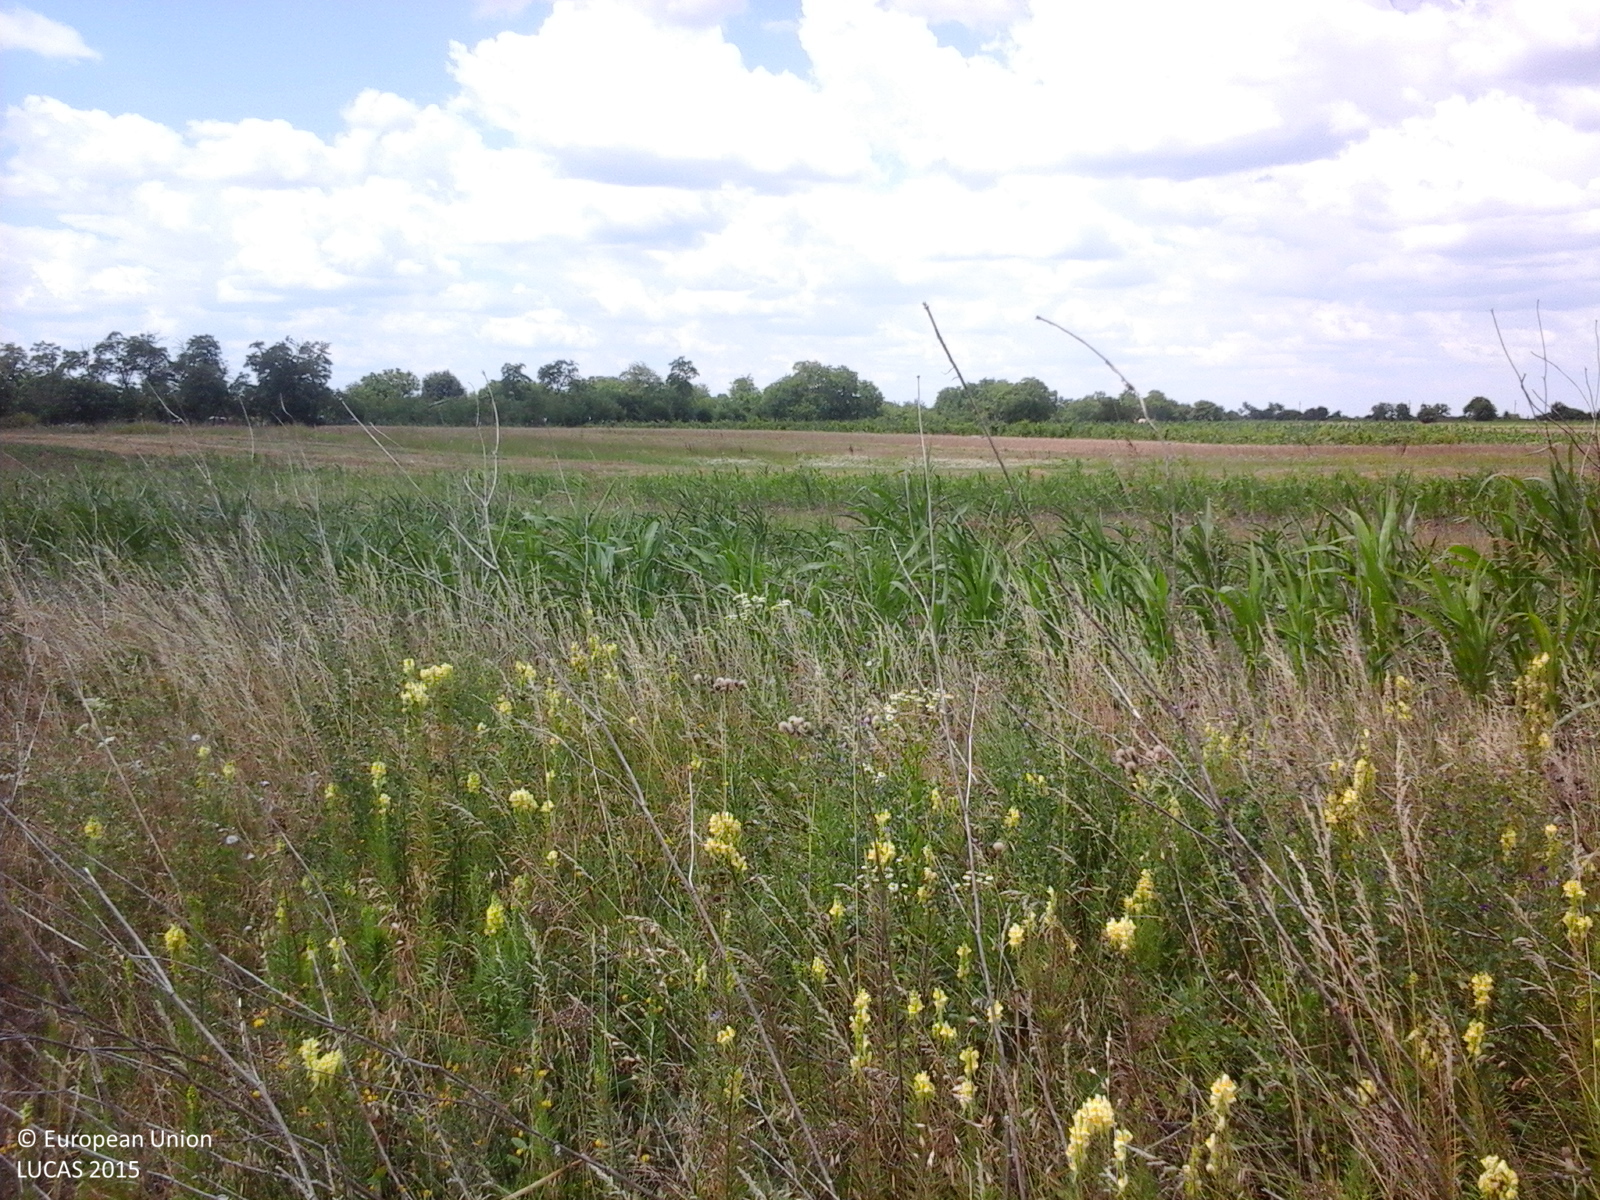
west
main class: Grassland
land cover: Spontaneously vegetated surfaces
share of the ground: > 75 %
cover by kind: herbaceous plants 100 %
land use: Fallow land
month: July
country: RO
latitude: 44.2906
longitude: 25.4148
